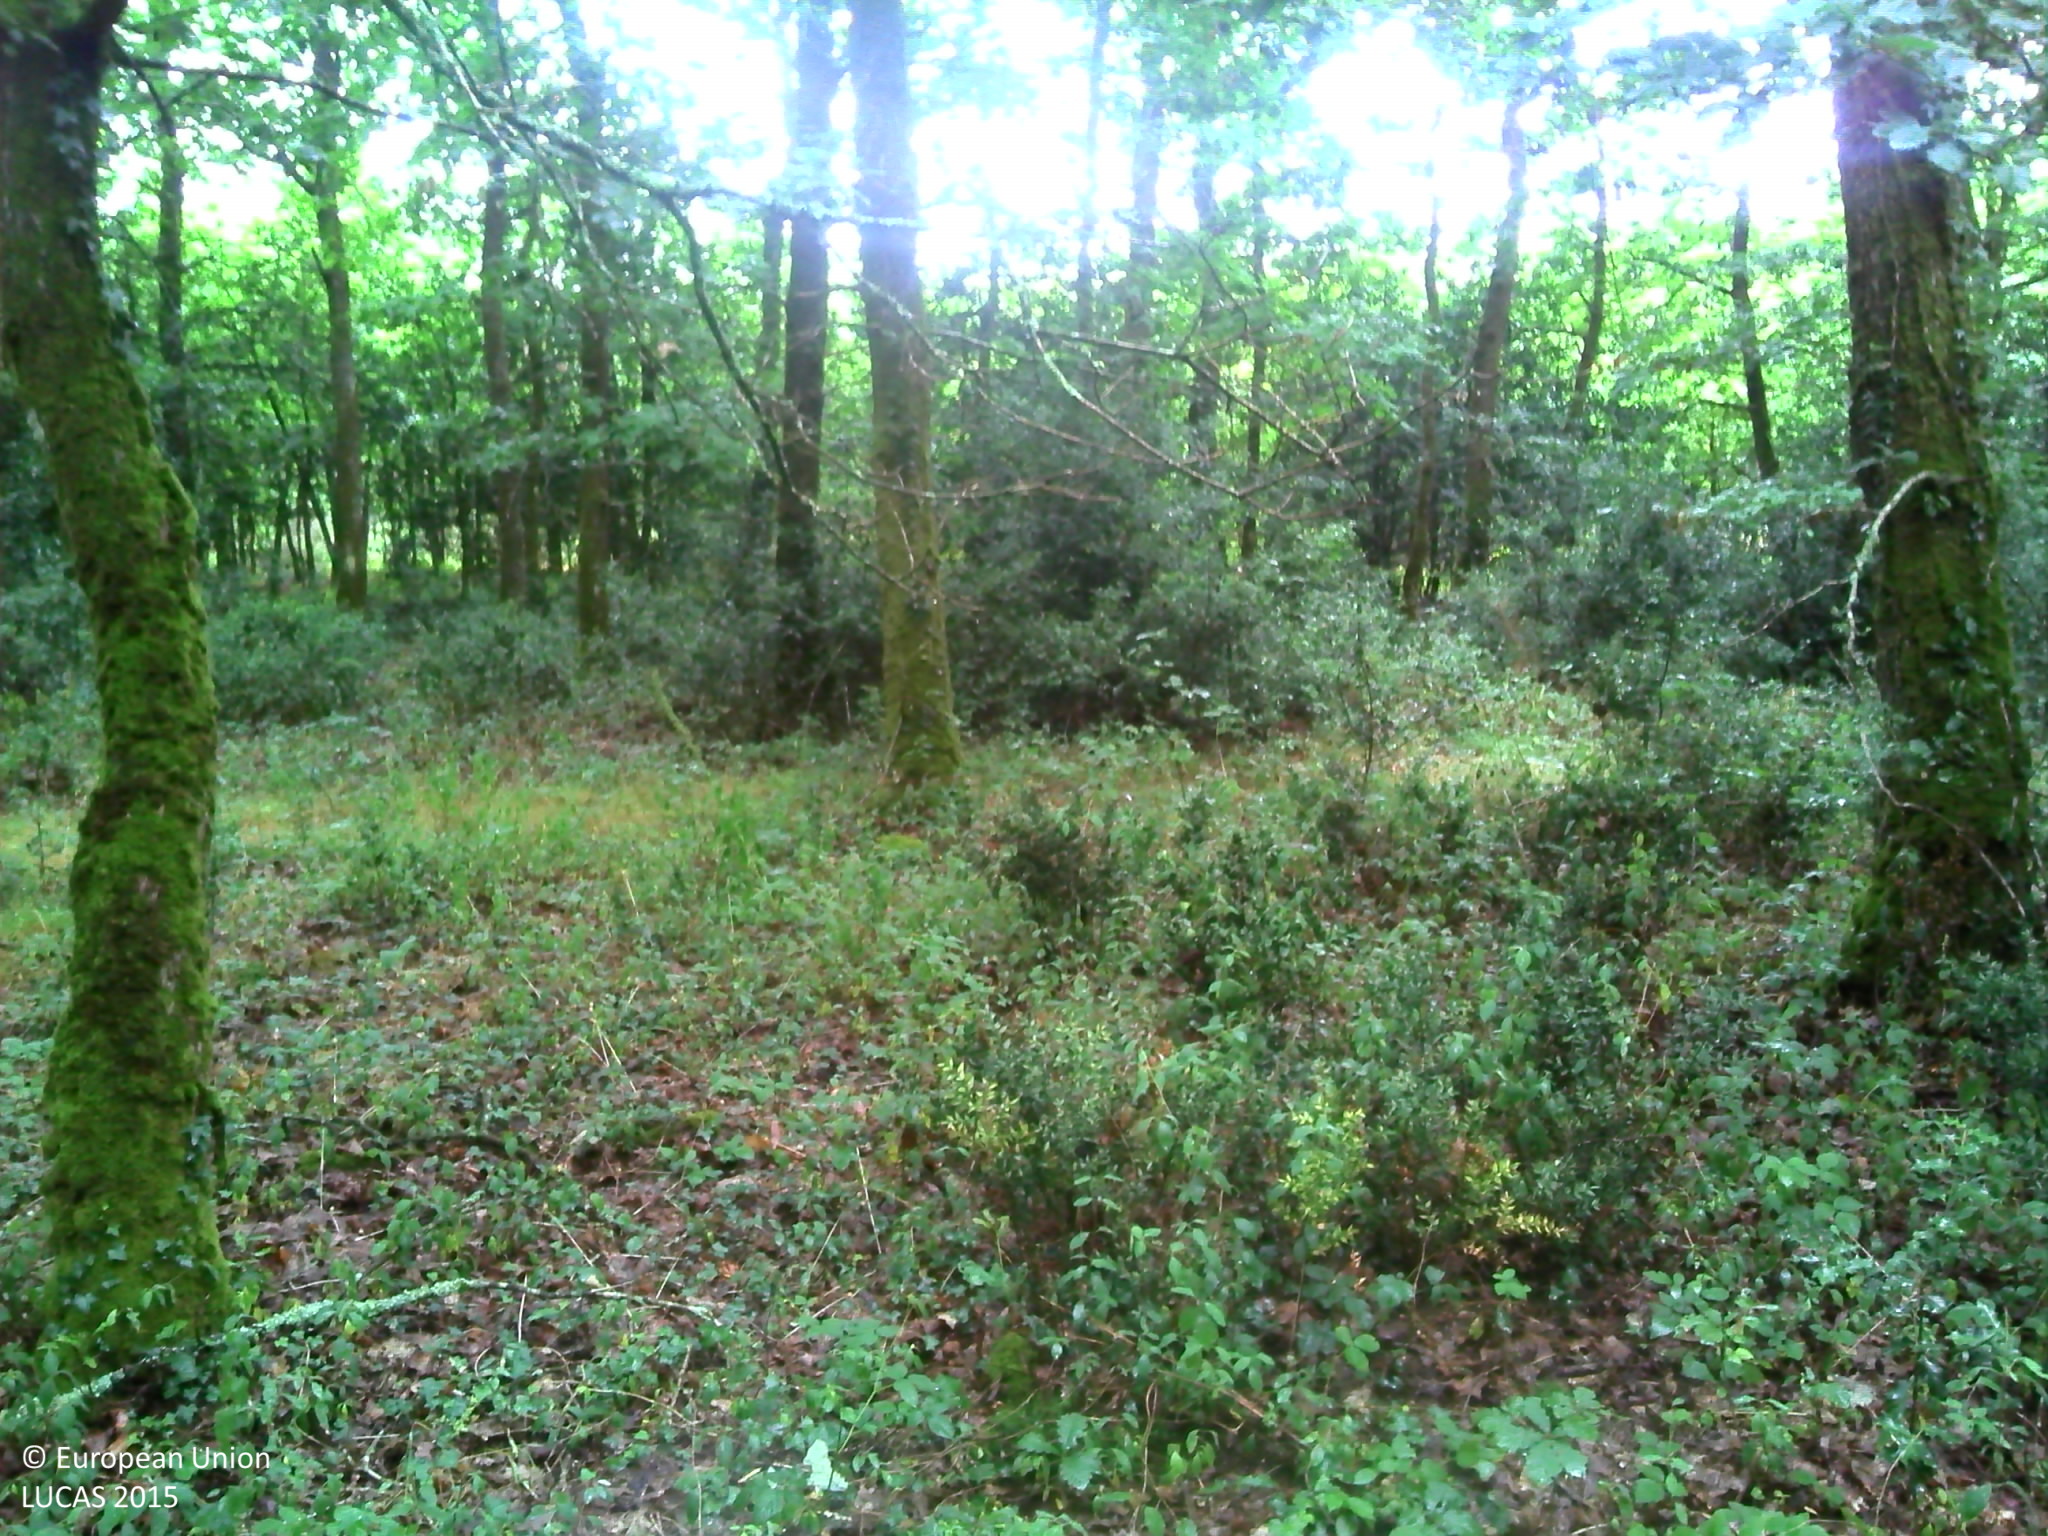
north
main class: Woodland
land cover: Broadleaved woodland
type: acidophilous oak and oak-birch forest
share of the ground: > 75 %
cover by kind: broadleaved forest trees 95 %, herbaceous plants 5 %
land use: Forestry
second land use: Amenities, museums, leisure
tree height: > 5 m
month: July
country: FR
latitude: 47.4969
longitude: -1.7946
